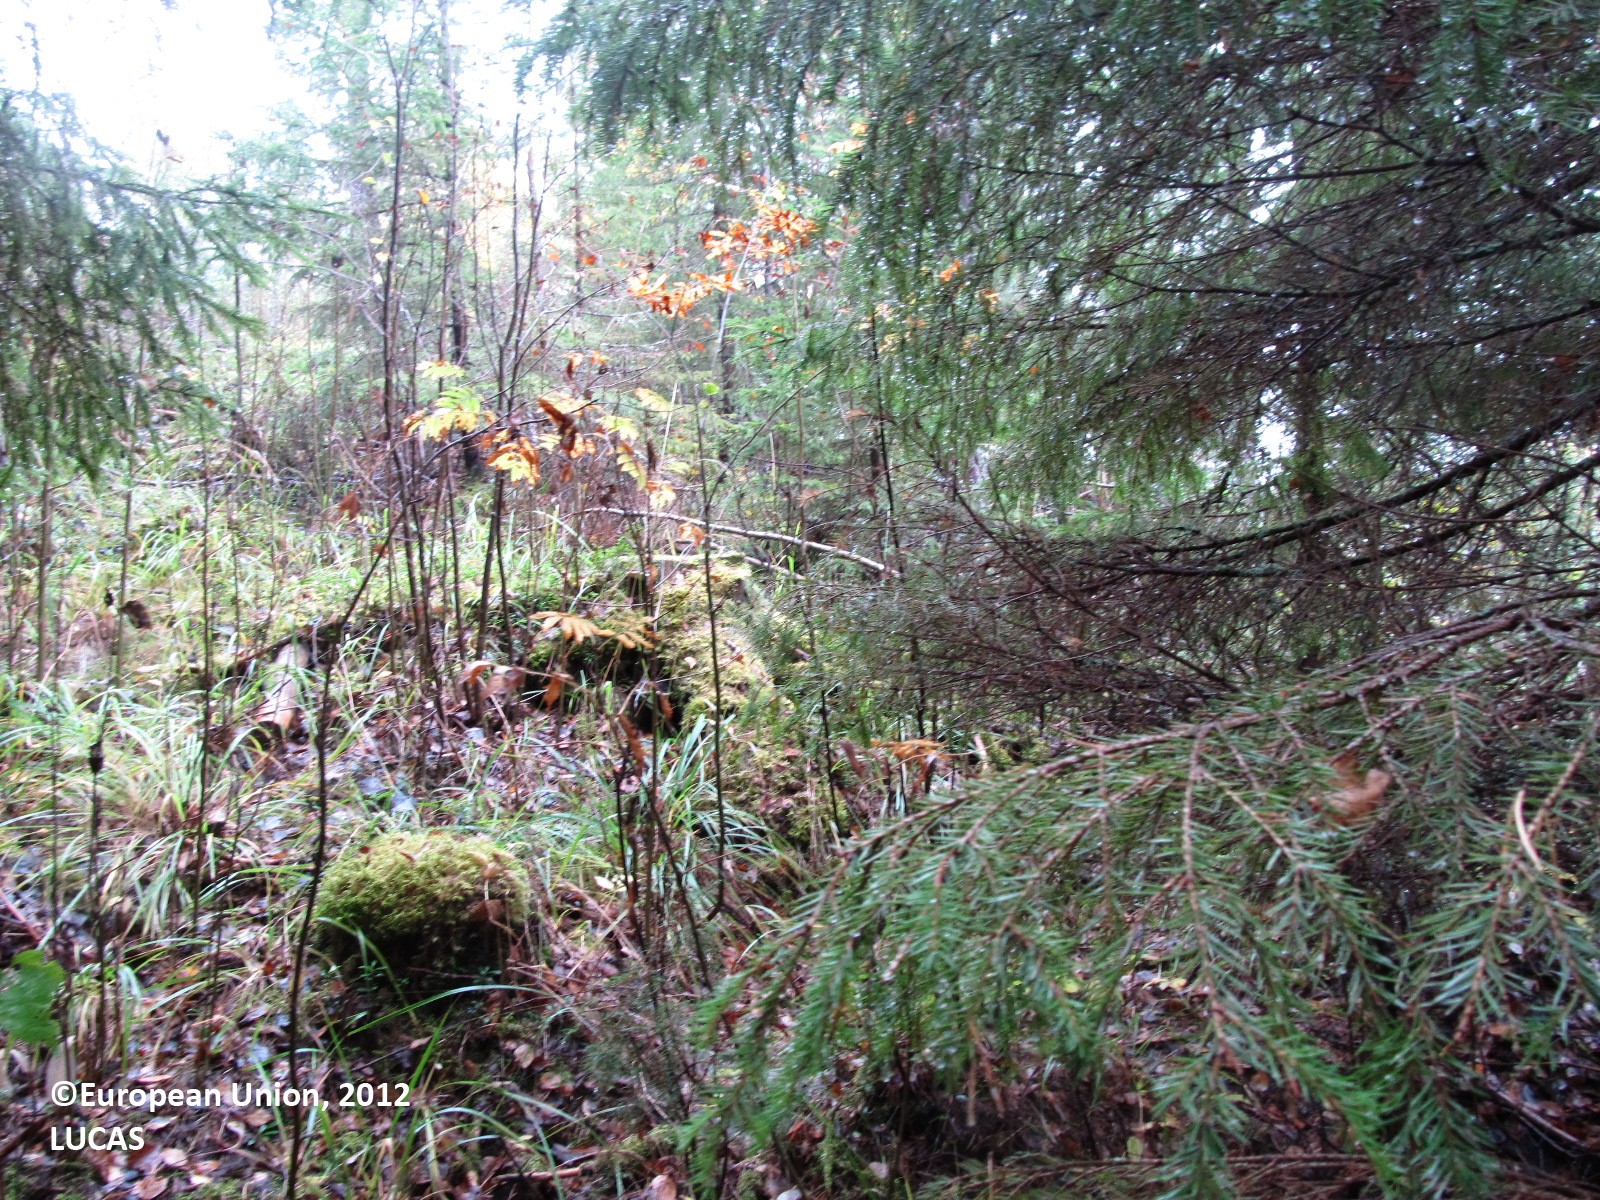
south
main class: Woodland
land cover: Spruce dominated coniferous woodland
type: boreal forest
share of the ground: 50 - 75 %
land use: Forestry
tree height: > 5 m
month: September
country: FI
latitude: 62.5739
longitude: 27.9890
